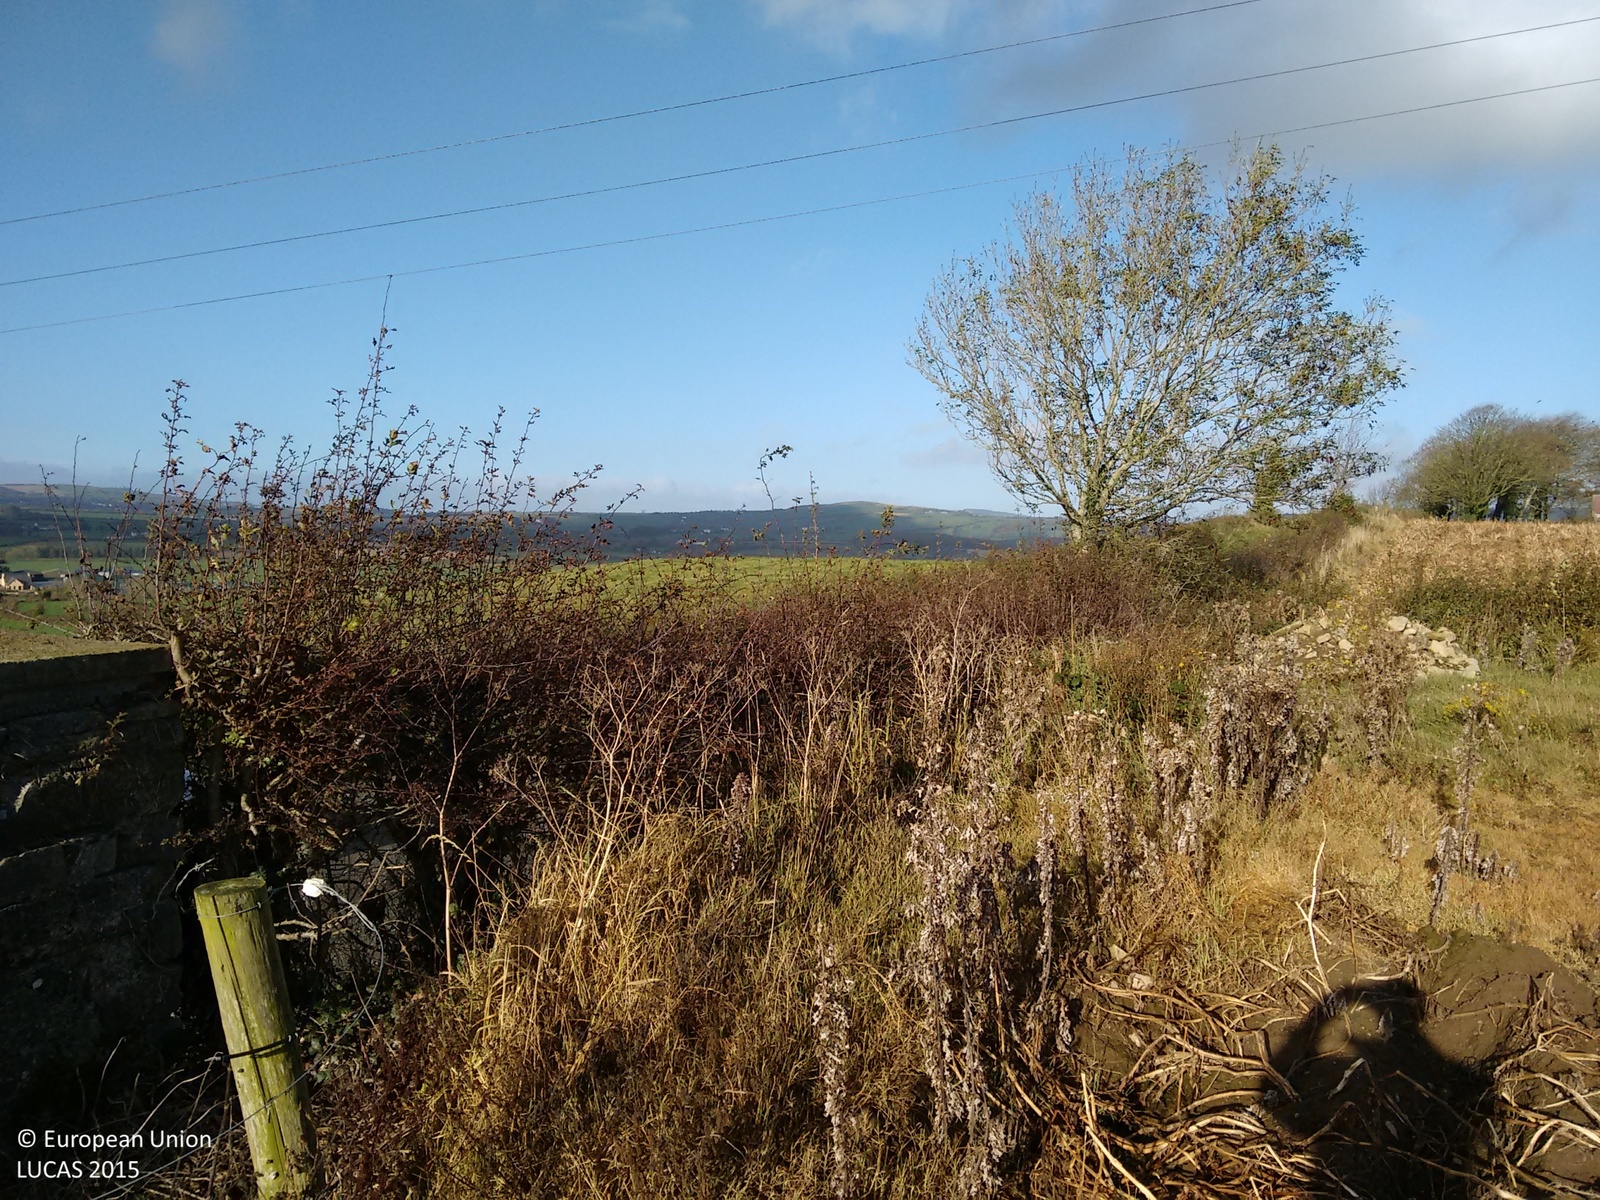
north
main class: Cropland
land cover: Potatoes
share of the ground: 10 - 25 %
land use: Agriculture (excluding fallow land and kitchen gardens)
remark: Harvested field
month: November
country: IE
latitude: 54.8562
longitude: -7.5241
